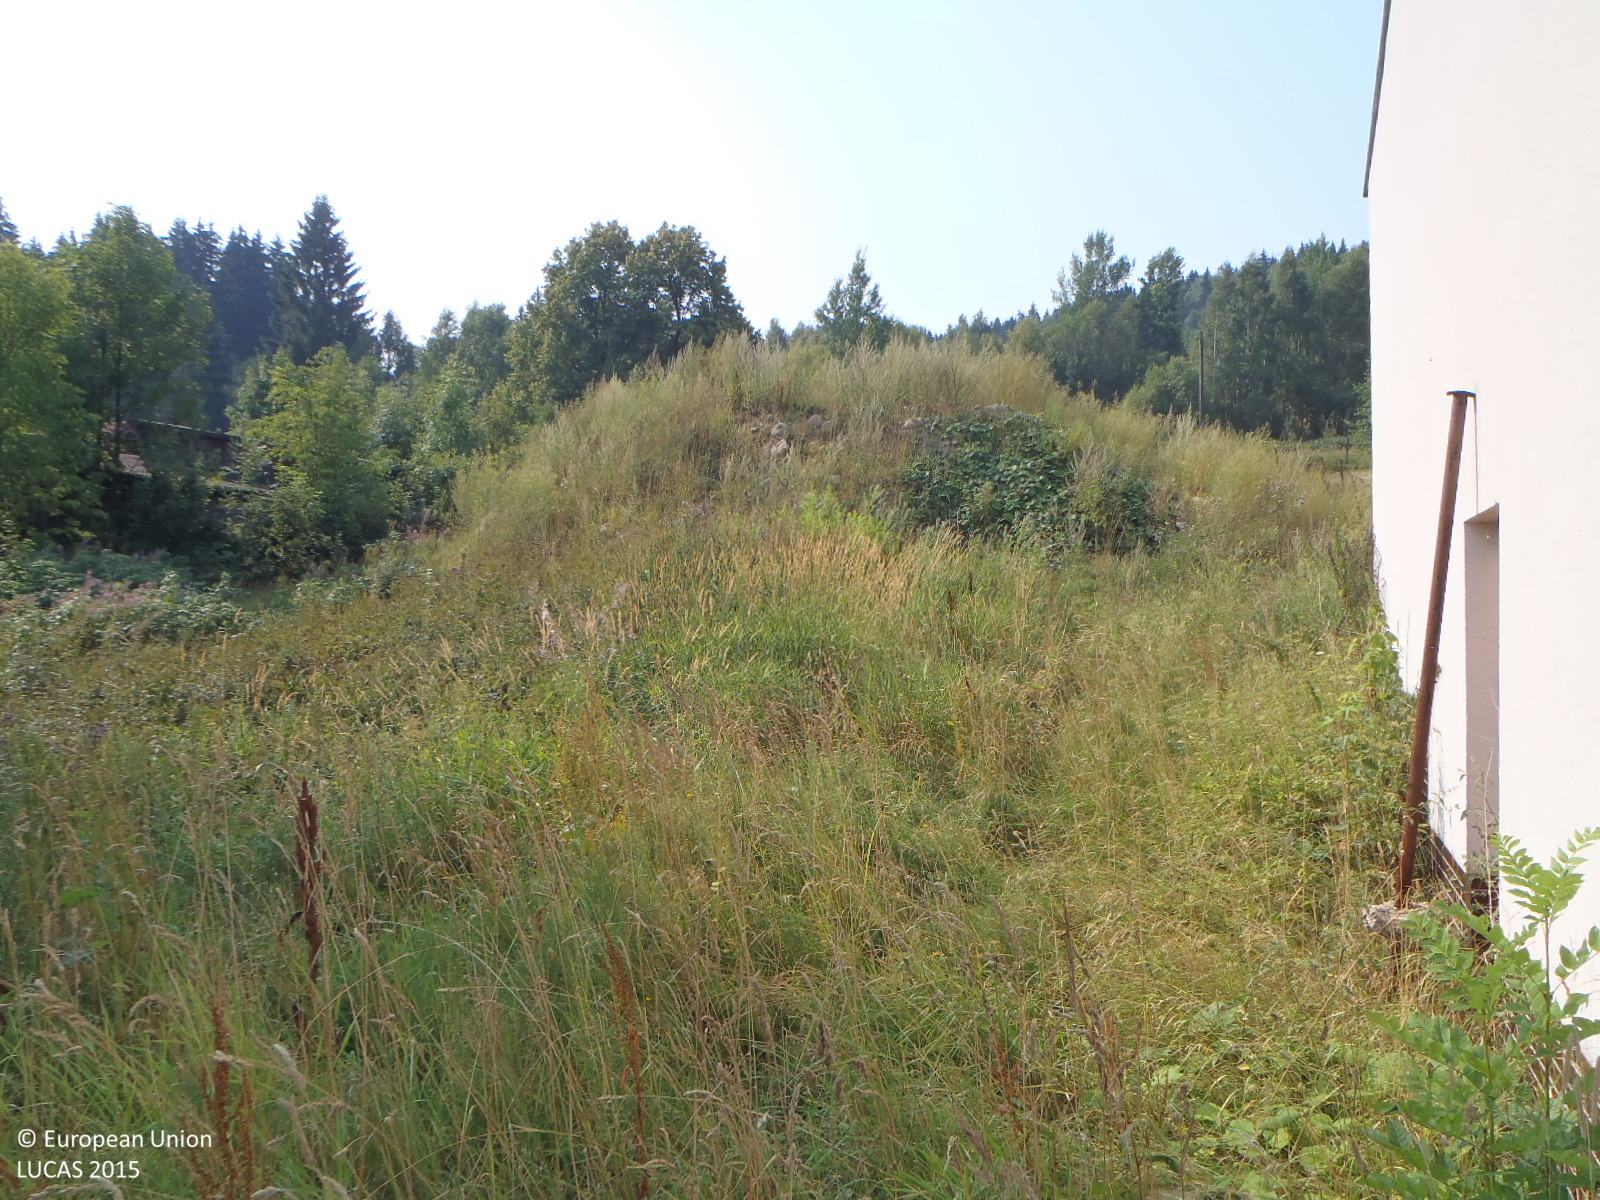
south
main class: Grassland
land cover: Spontaneously vegetated surfaces
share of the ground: > 75 %
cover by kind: herbaceous plants 100 %
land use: Coal, oil and metal processing
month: August
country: CZ
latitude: 50.7296
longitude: 15.2596
